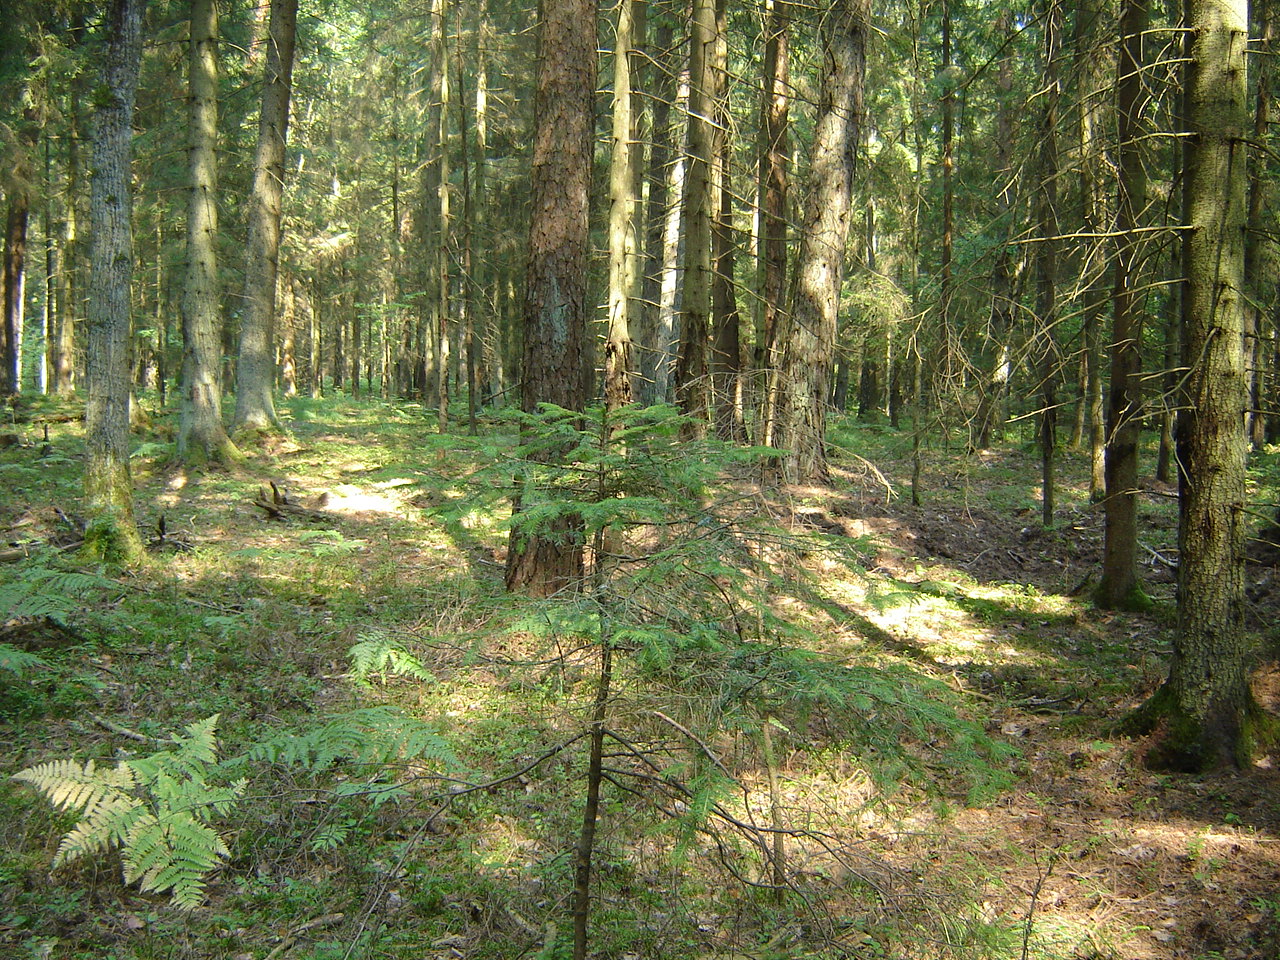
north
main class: Woodland
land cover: Spruce dominated coniferous woodland
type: hemiboreal forest and nemoral coniferous forest and mixed broadleaved-coniferous forest
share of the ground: > 75 %
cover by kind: coniferous forest trees 75 %, broadleaved forest trees 10 %, lichens and mosses 10 %, herbaceous plants 5 %
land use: Forestry
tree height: > 5 m
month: August
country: LT
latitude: 54.8951
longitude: 25.0045
